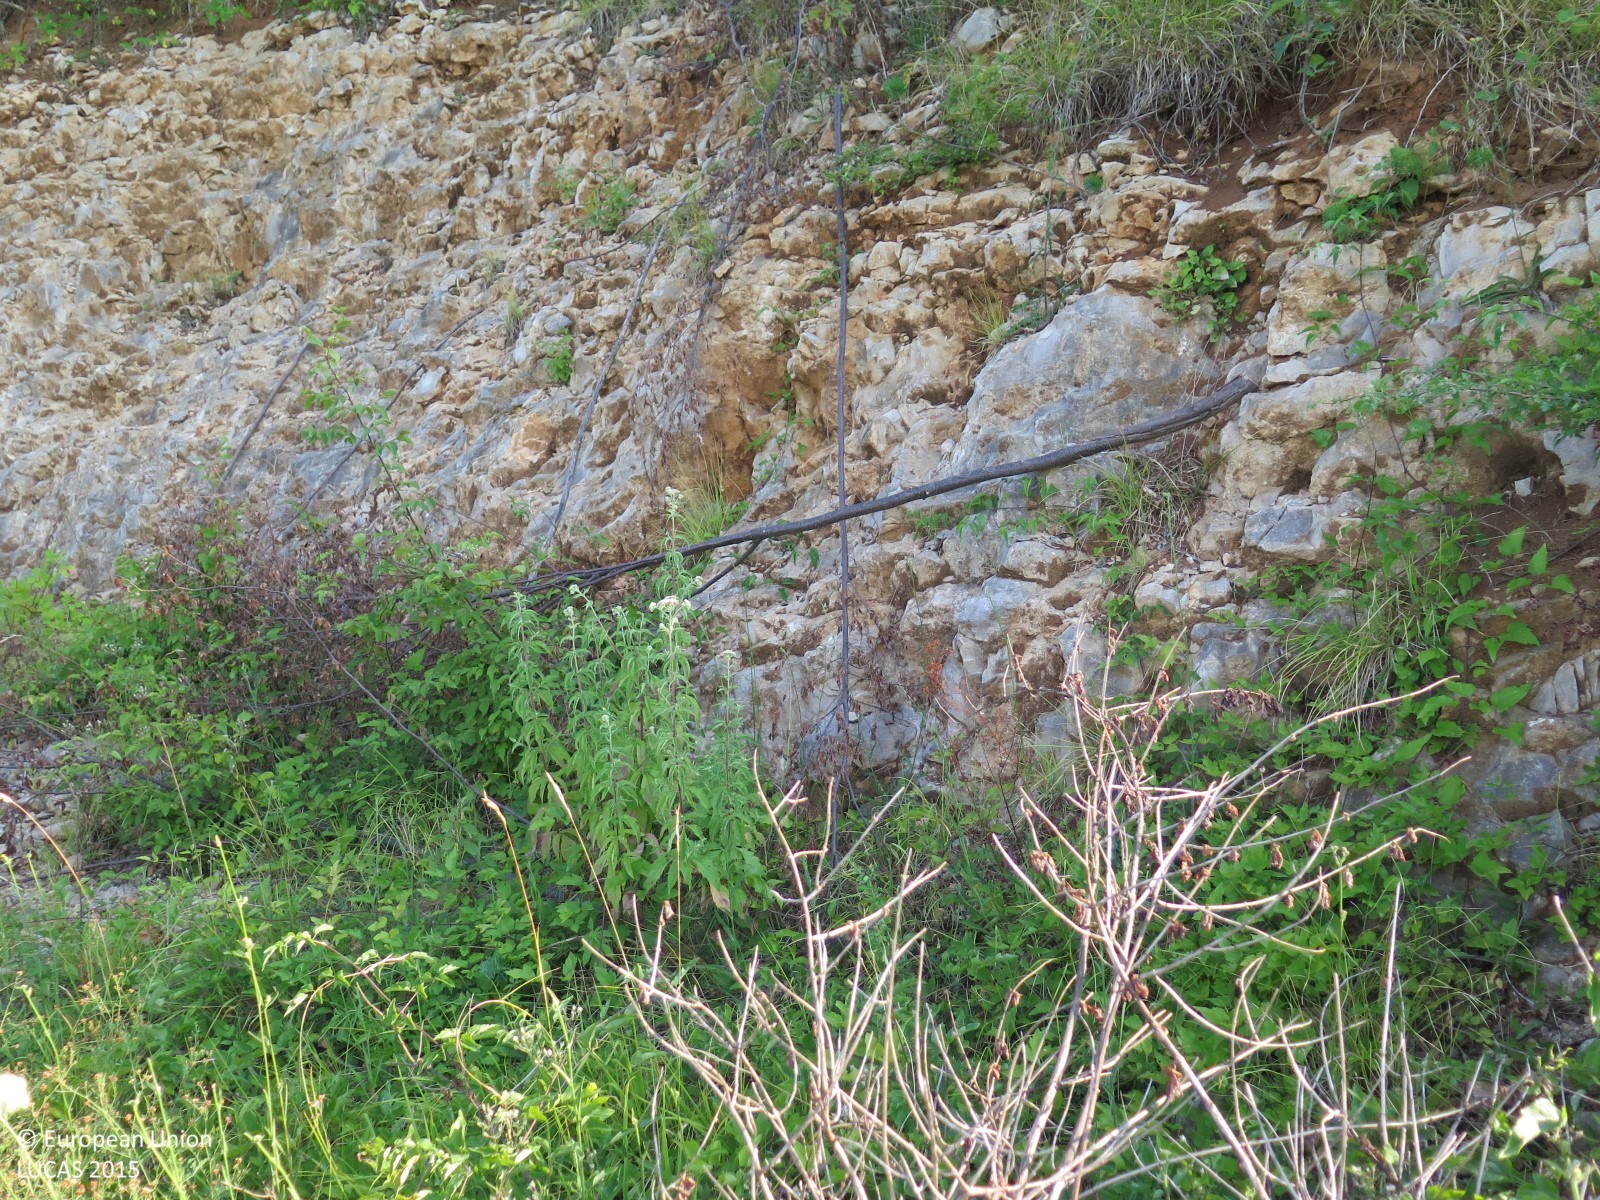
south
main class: Woodland
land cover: Broadleaved woodland
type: acidophilous oak and oak-birch forest
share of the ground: > 75 %
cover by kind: broadleaved forest trees 90 %, shrubs 5 %, herbaceous plants 5 %
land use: Semi-natural and natural areas not in use
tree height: > 5 m
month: July
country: HR
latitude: 45.1920
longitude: 14.0550
